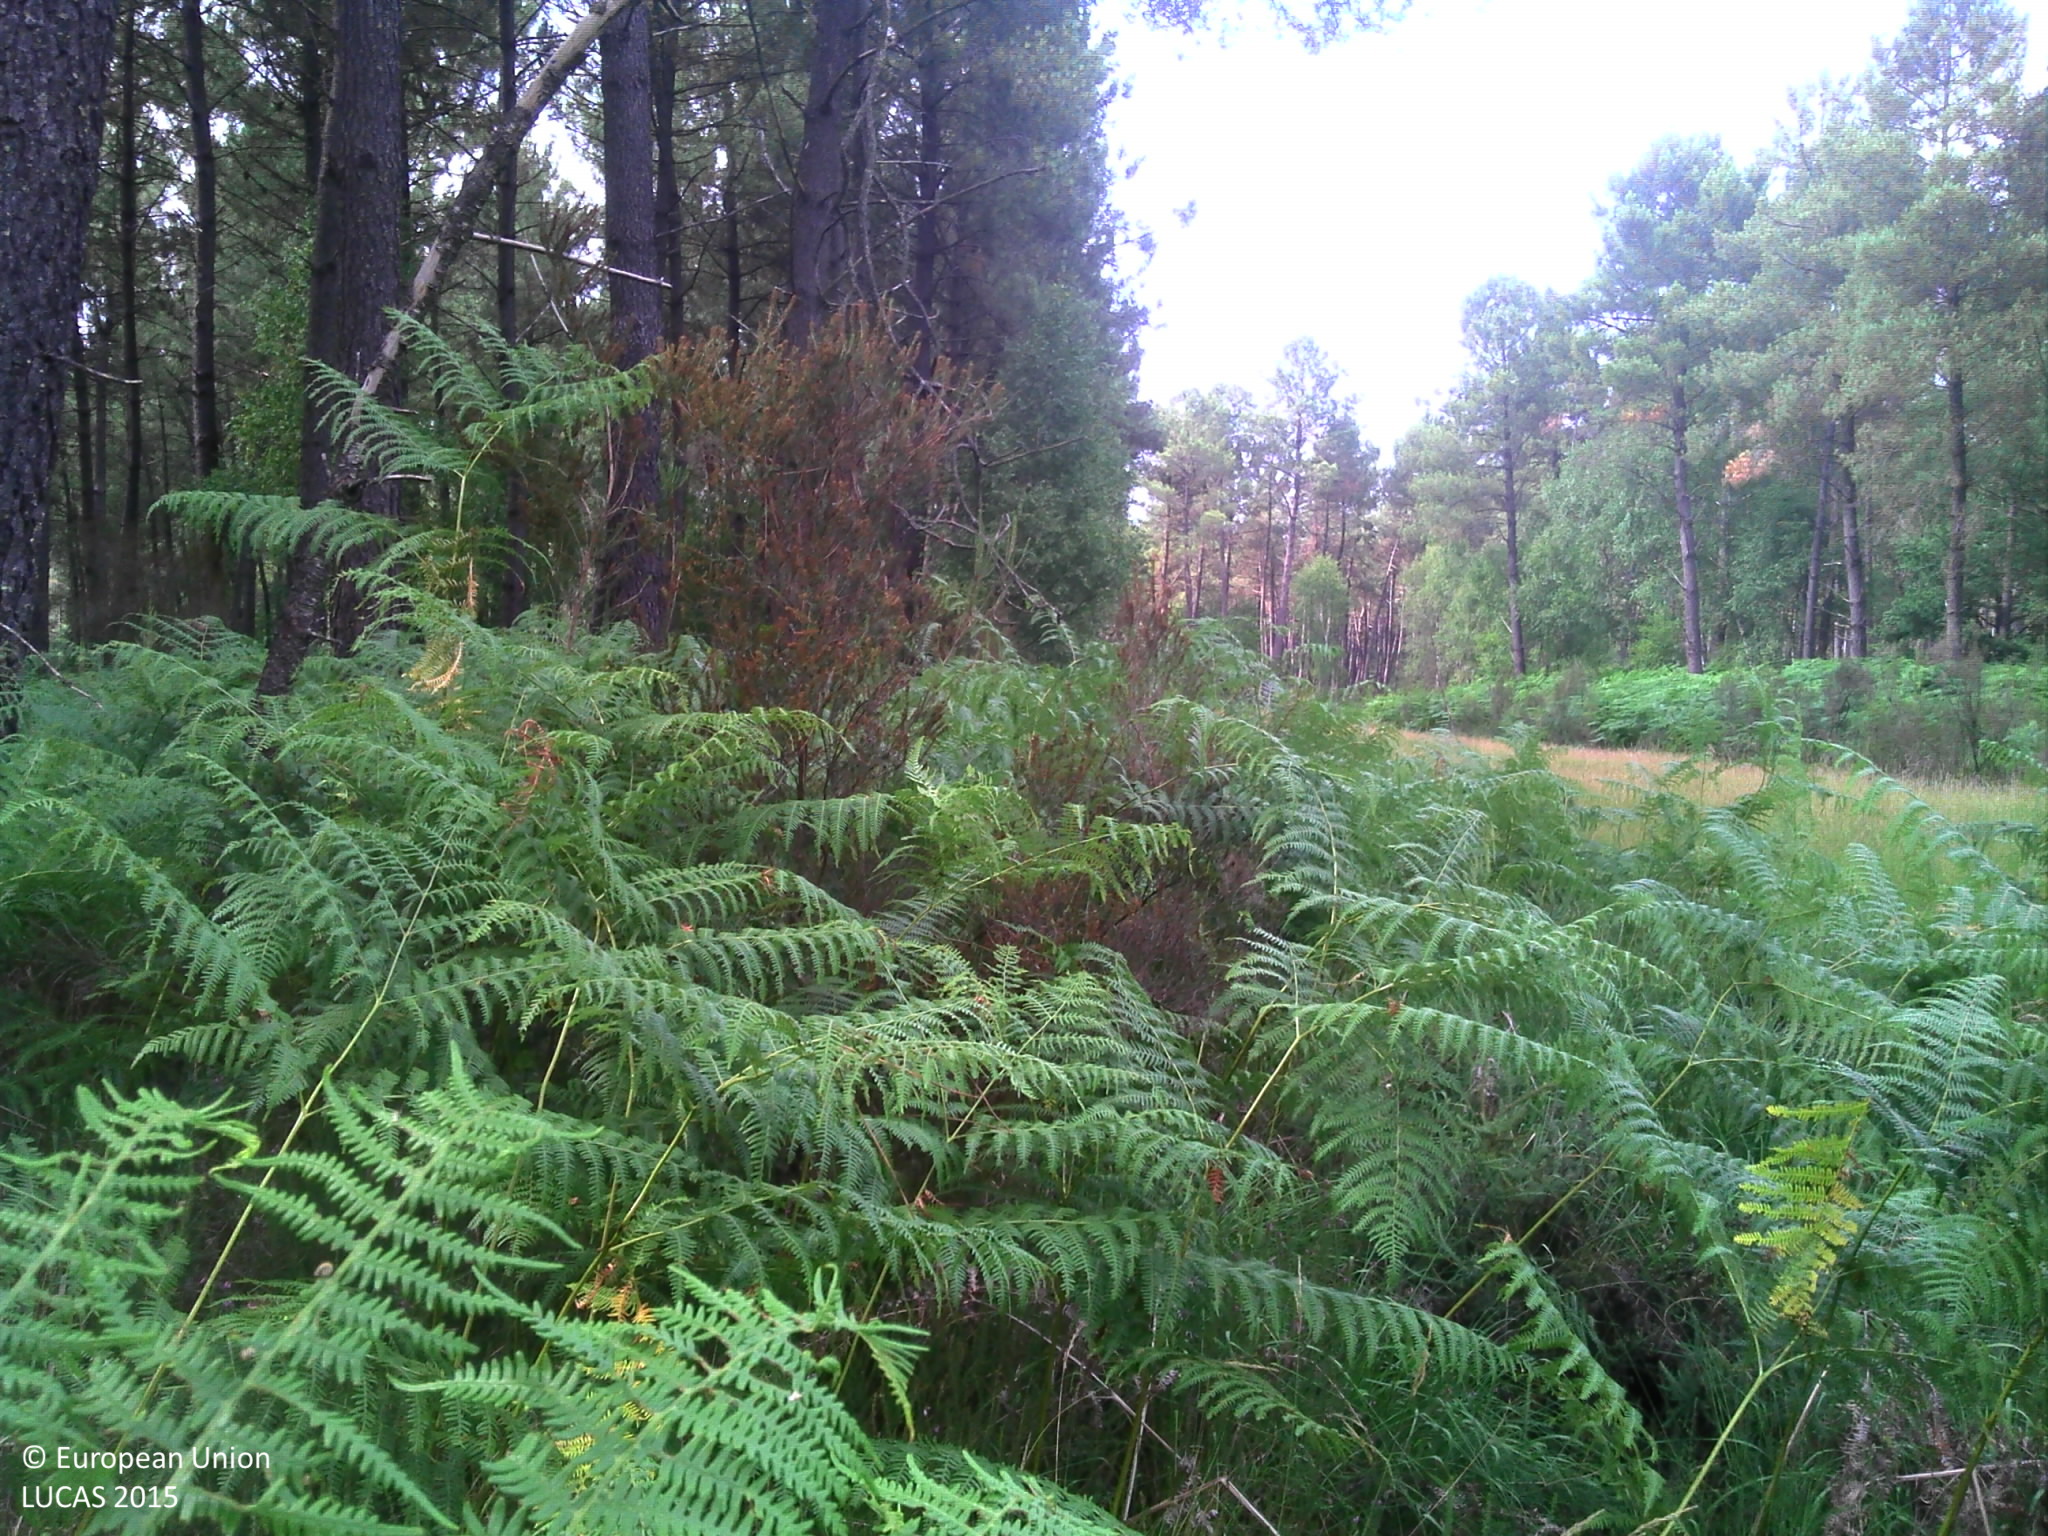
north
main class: Woodland
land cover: Pine dominated coniferous woodland
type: mesophytic deciduous forest
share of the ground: > 75 %
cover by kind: coniferous forest trees 65 %, broadleaved forest trees 10 %, shrubs 10 %, herbaceous plants 10 %, lichens and mosses 5 %
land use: Forestry
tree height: > 5 m
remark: Fire break
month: July
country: FR
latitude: 47.2017
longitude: 0.3551
